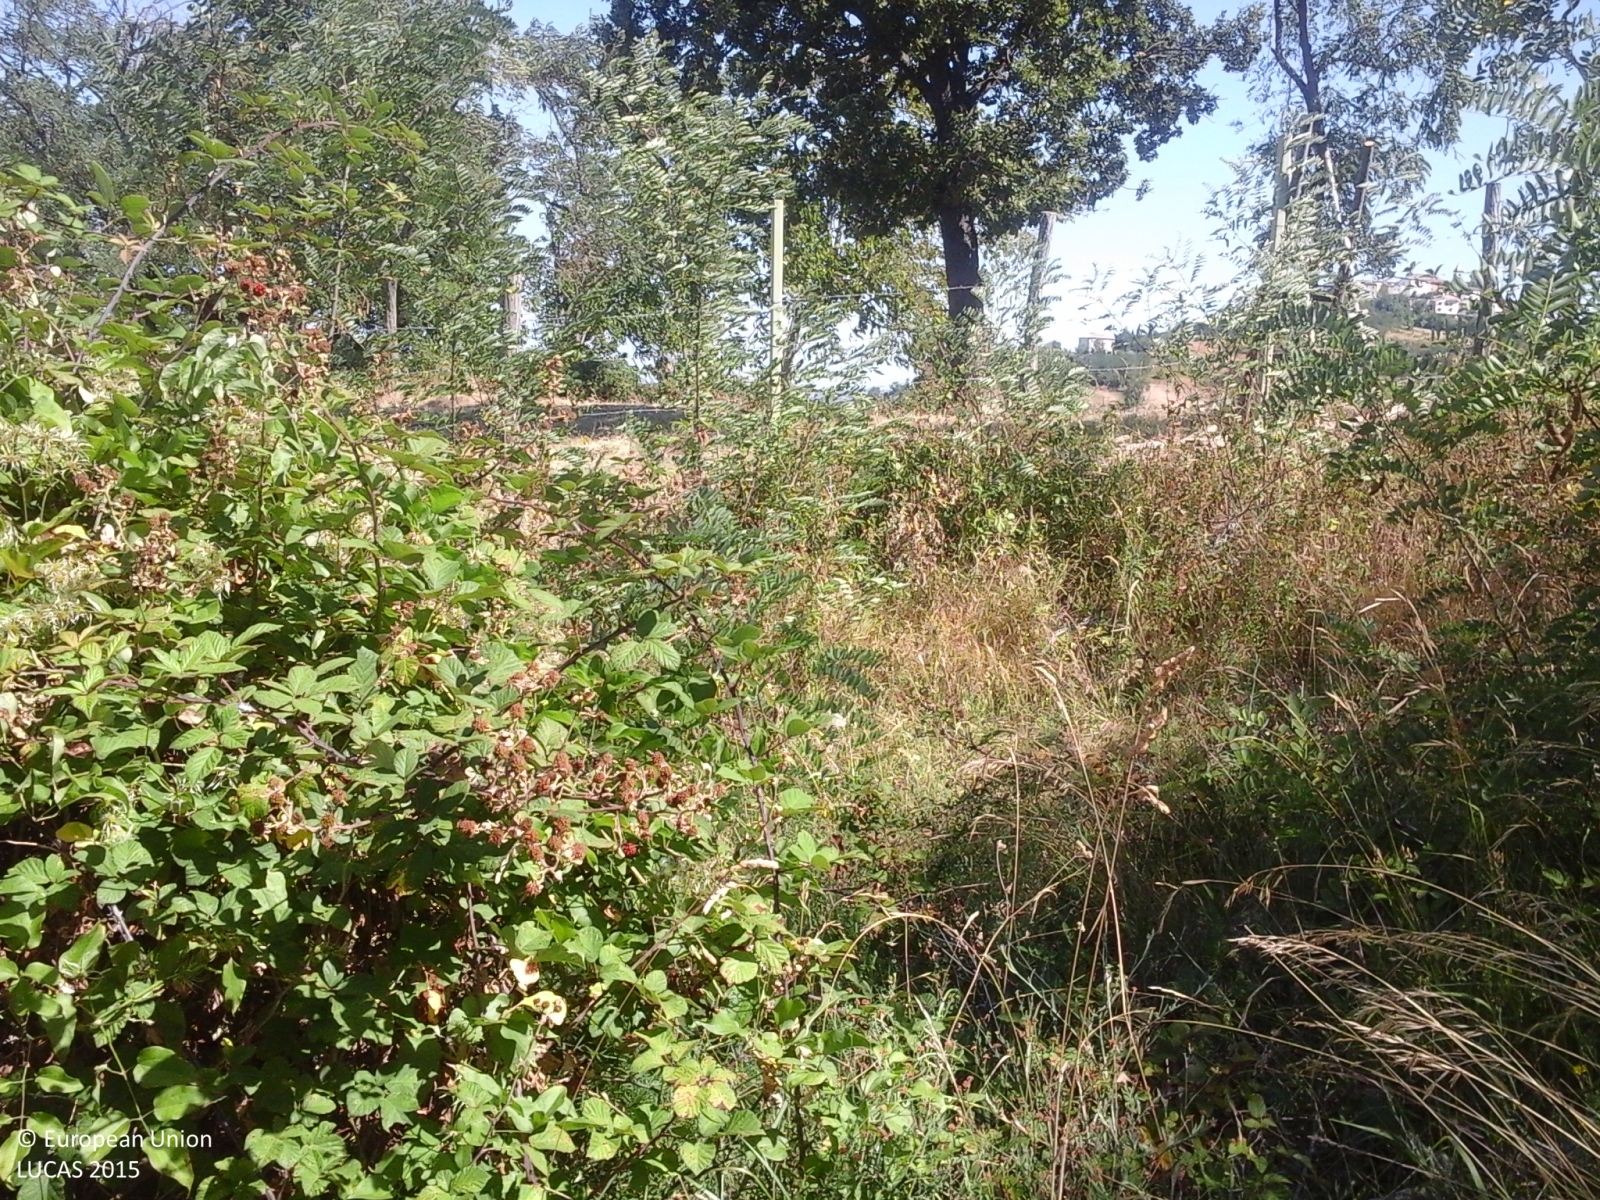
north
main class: Woodland
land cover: Broadleaved woodland
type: thermophilous deciduous forest
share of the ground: > 75 %
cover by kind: broadleaved forest trees 75 %, shrubs 25 %
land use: Forestry
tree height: > 5 m
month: July
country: IT
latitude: 43.9478
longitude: 12.2250
